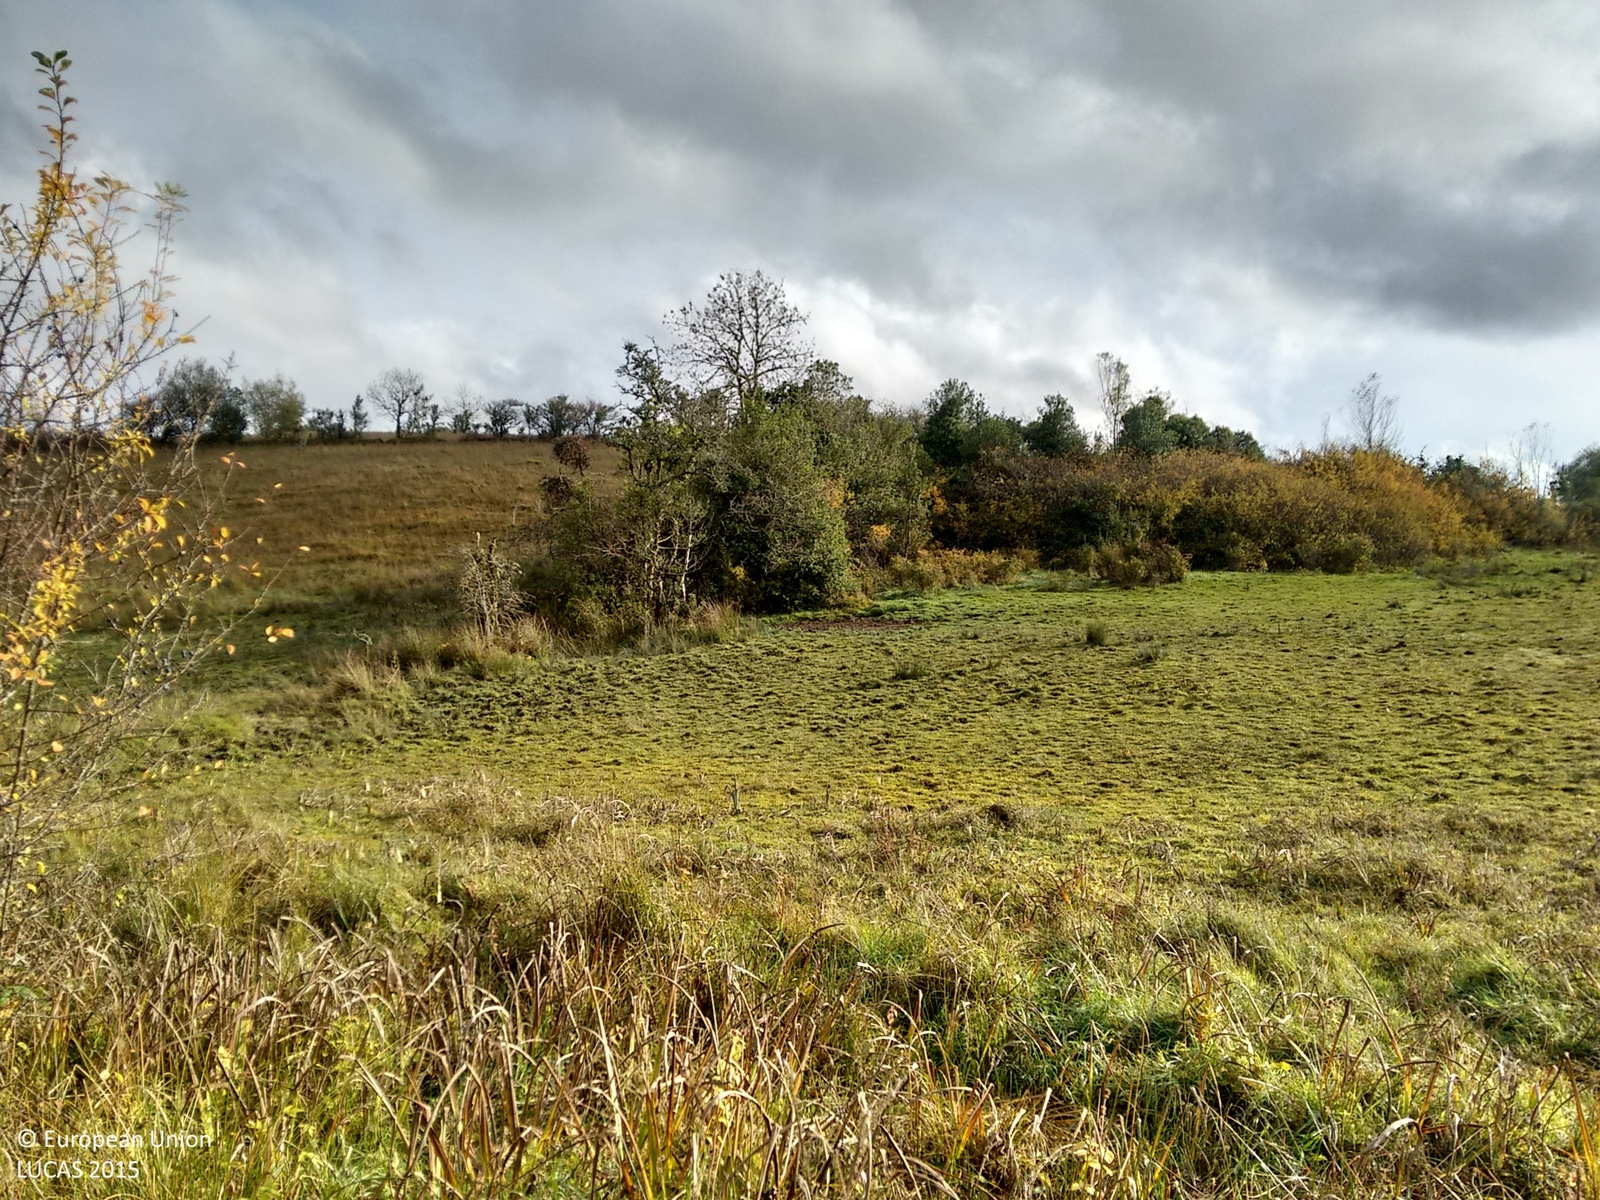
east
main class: Grassland
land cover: Grassland with sparse tree/shrub cover
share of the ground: > 75 %
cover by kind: herbaceous plants 95 %, broadleaved forest trees 5 %
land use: Agriculture (excluding fallow land and kitchen gardens)
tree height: > 5 m
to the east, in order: Grassland with sparse tree/shrub cover; Broadleaved woodland; Grassland with sparse tree/shrub cover; Fences; Rivers and streams; Abandoned hedges; Fences; Grassland with sparse tree/shrub cover; Abandoned hedges; Grassland without tree/shrub cover; Broadleaved woodland; Grassland without tree/shrub cover; Broadleaved woodland
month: October
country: IE
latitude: 54.0520
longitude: -8.2214
